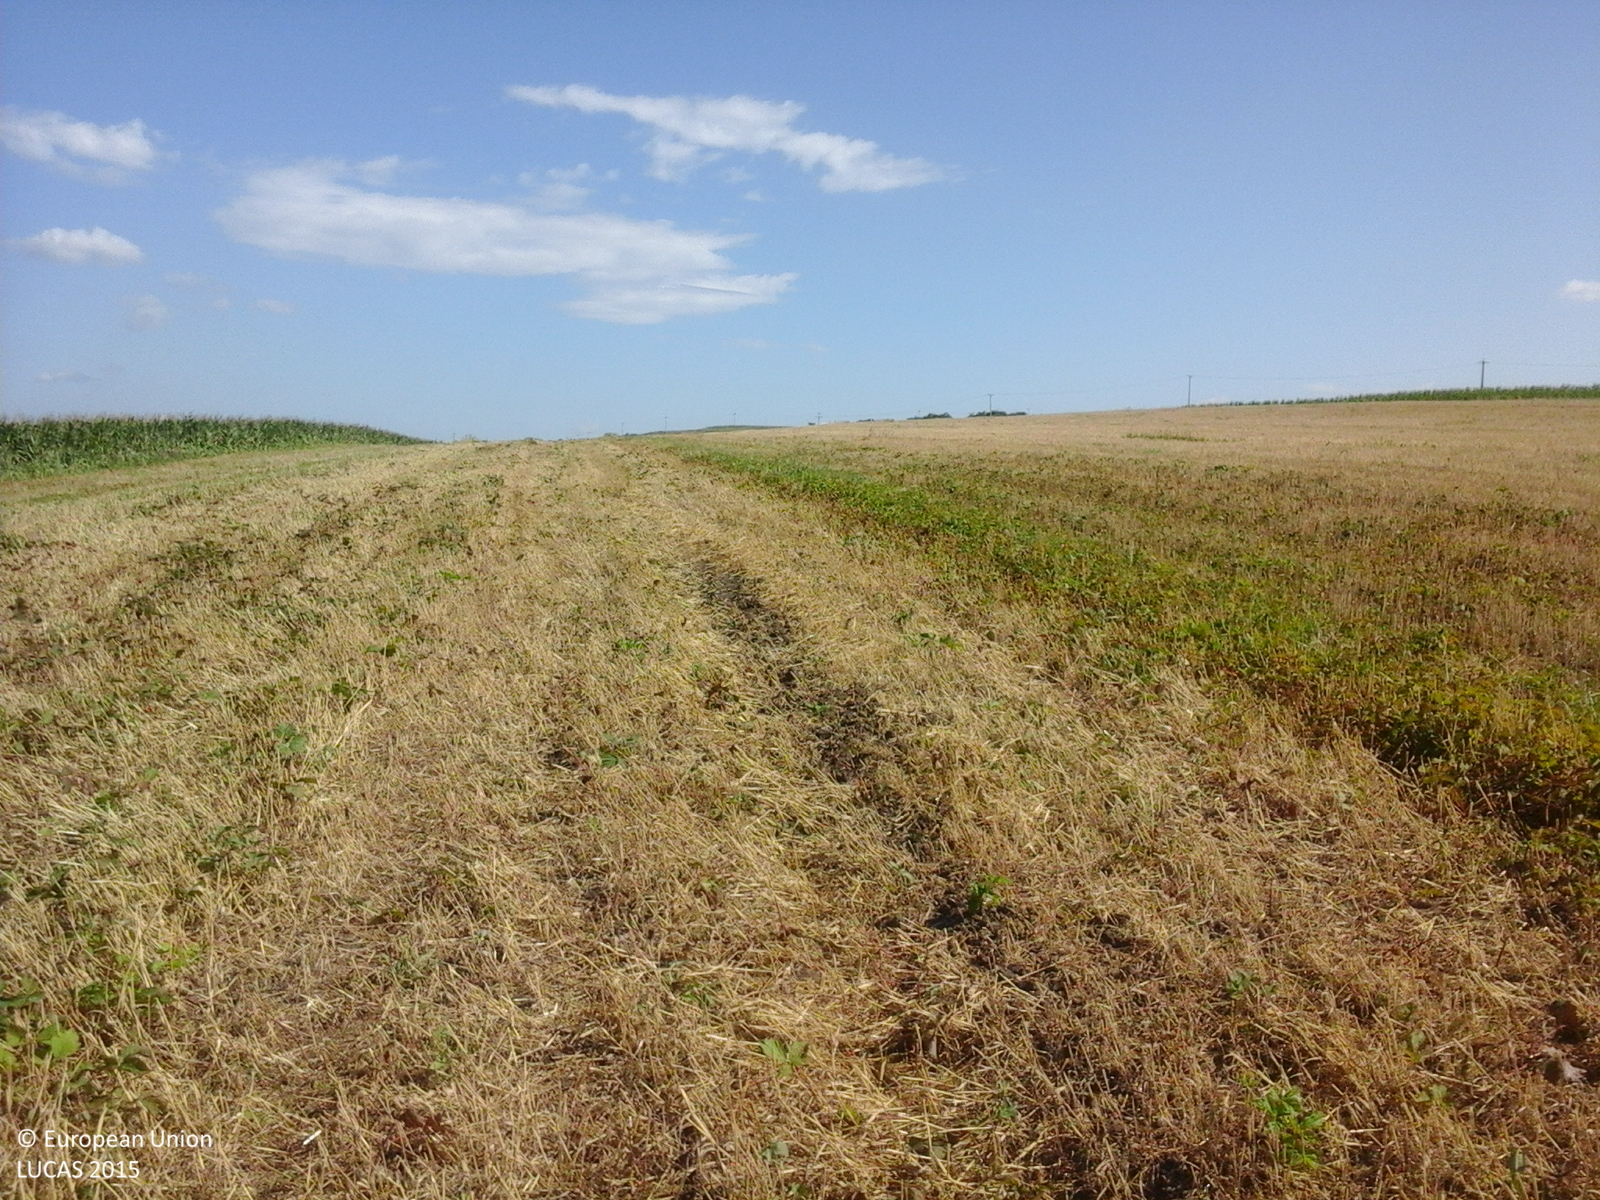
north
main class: Cropland
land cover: Common wheat
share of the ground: 50 - 75 %
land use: Agriculture (excluding fallow land and kitchen gardens)
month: July
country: RO
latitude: 46.1219
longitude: 27.7539
